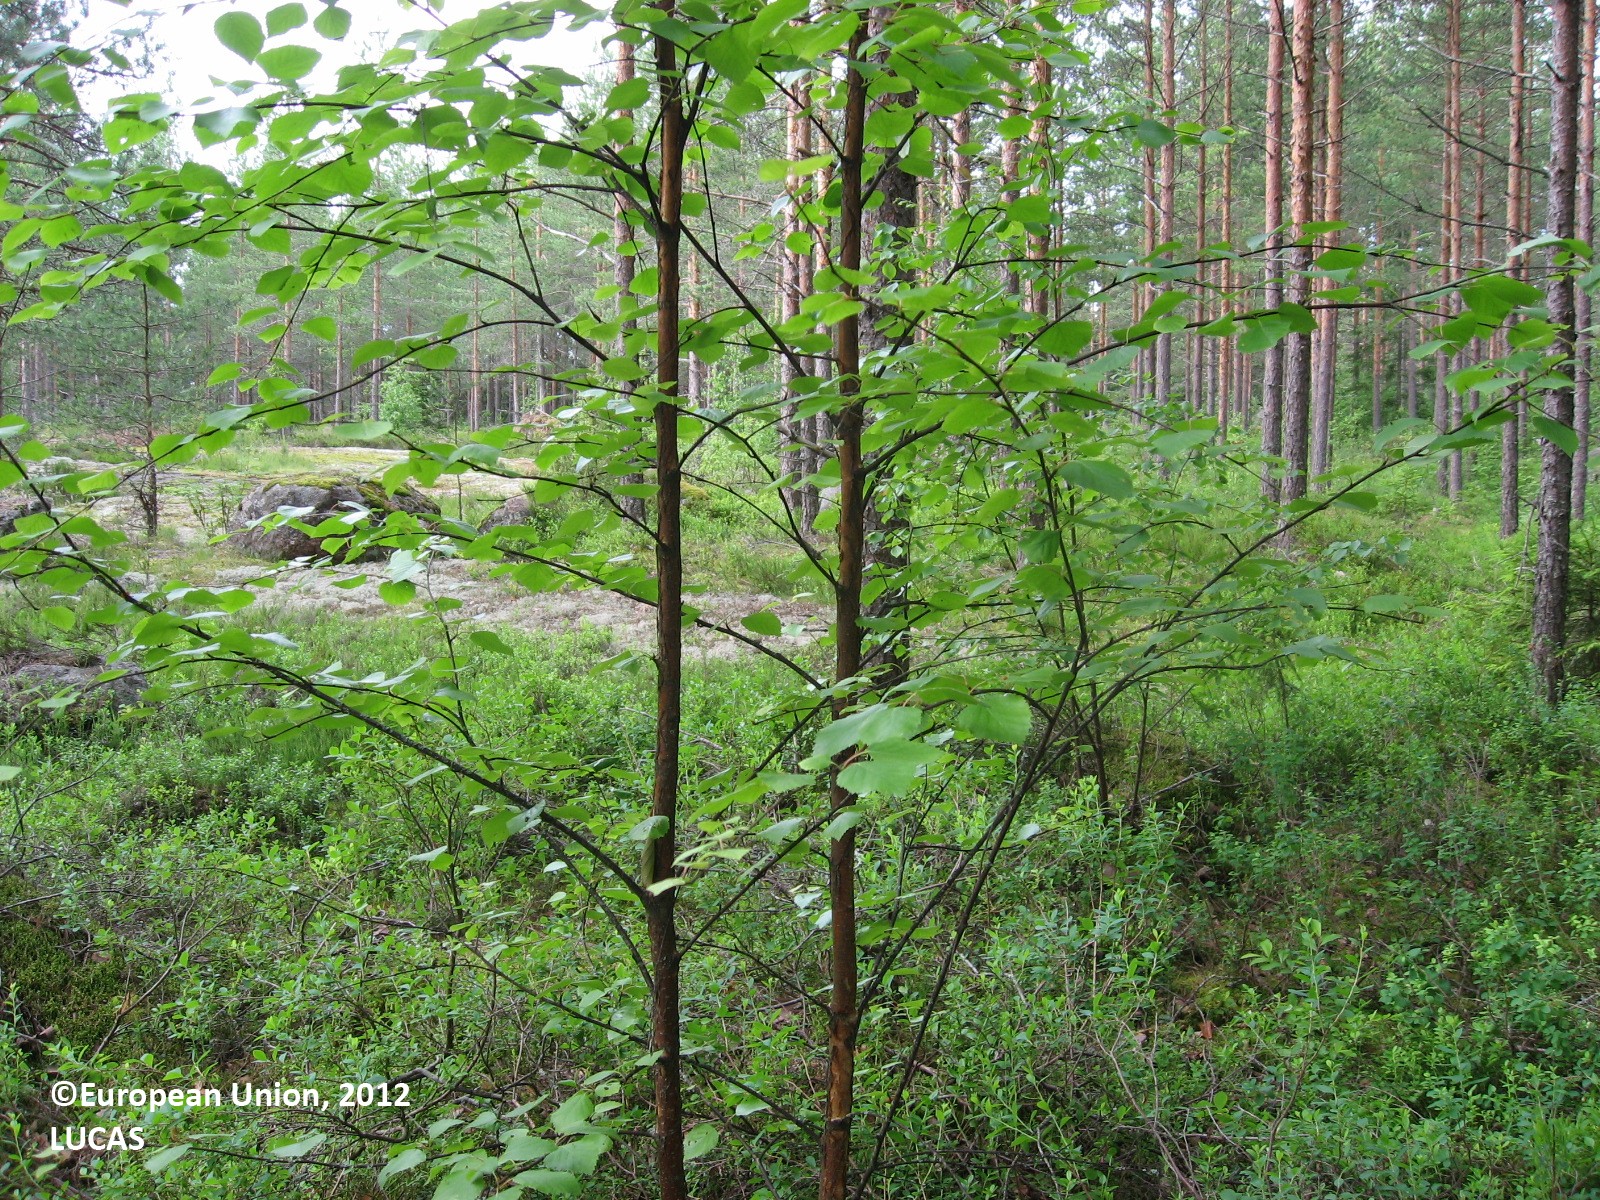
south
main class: Woodland
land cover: Pine dominated coniferous woodland
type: boreal forest
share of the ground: 50 - 75 %
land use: Forestry
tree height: > 5 m
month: June
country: FI
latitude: 60.6559
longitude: 26.1894
